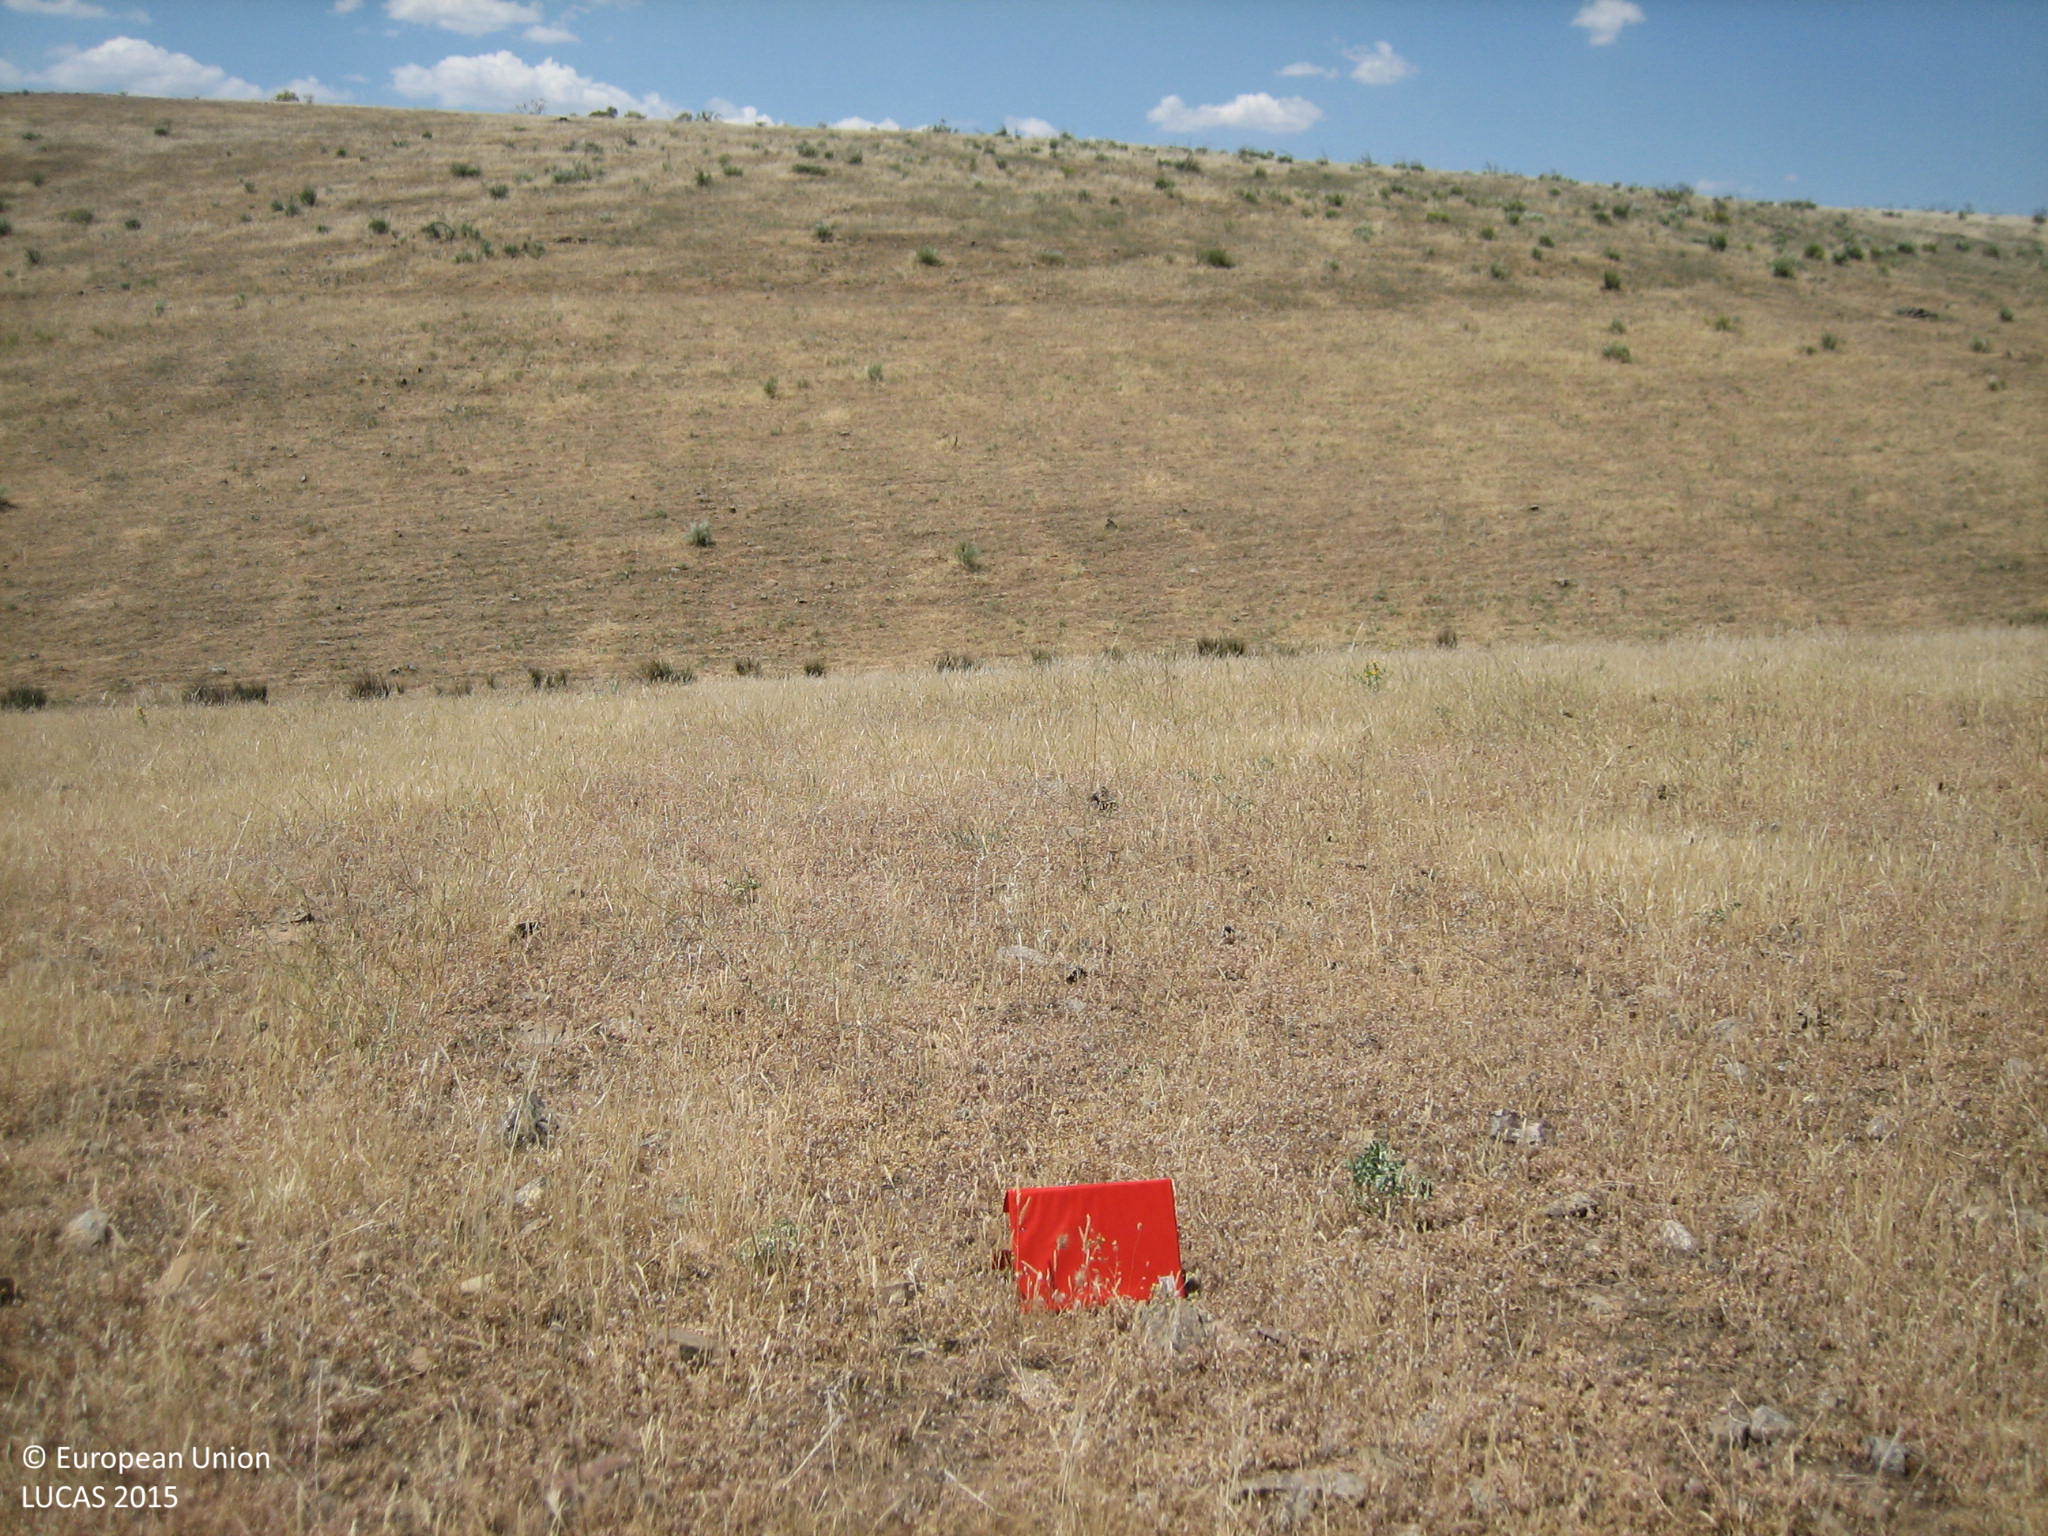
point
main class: Grassland
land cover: Grassland without tree/shrub cover
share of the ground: > 75 %
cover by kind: herbaceous plants 100 %
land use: Agriculture (excluding fallow land and kitchen gardens)
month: May
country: ES
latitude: 38.9017
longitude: -4.0538
